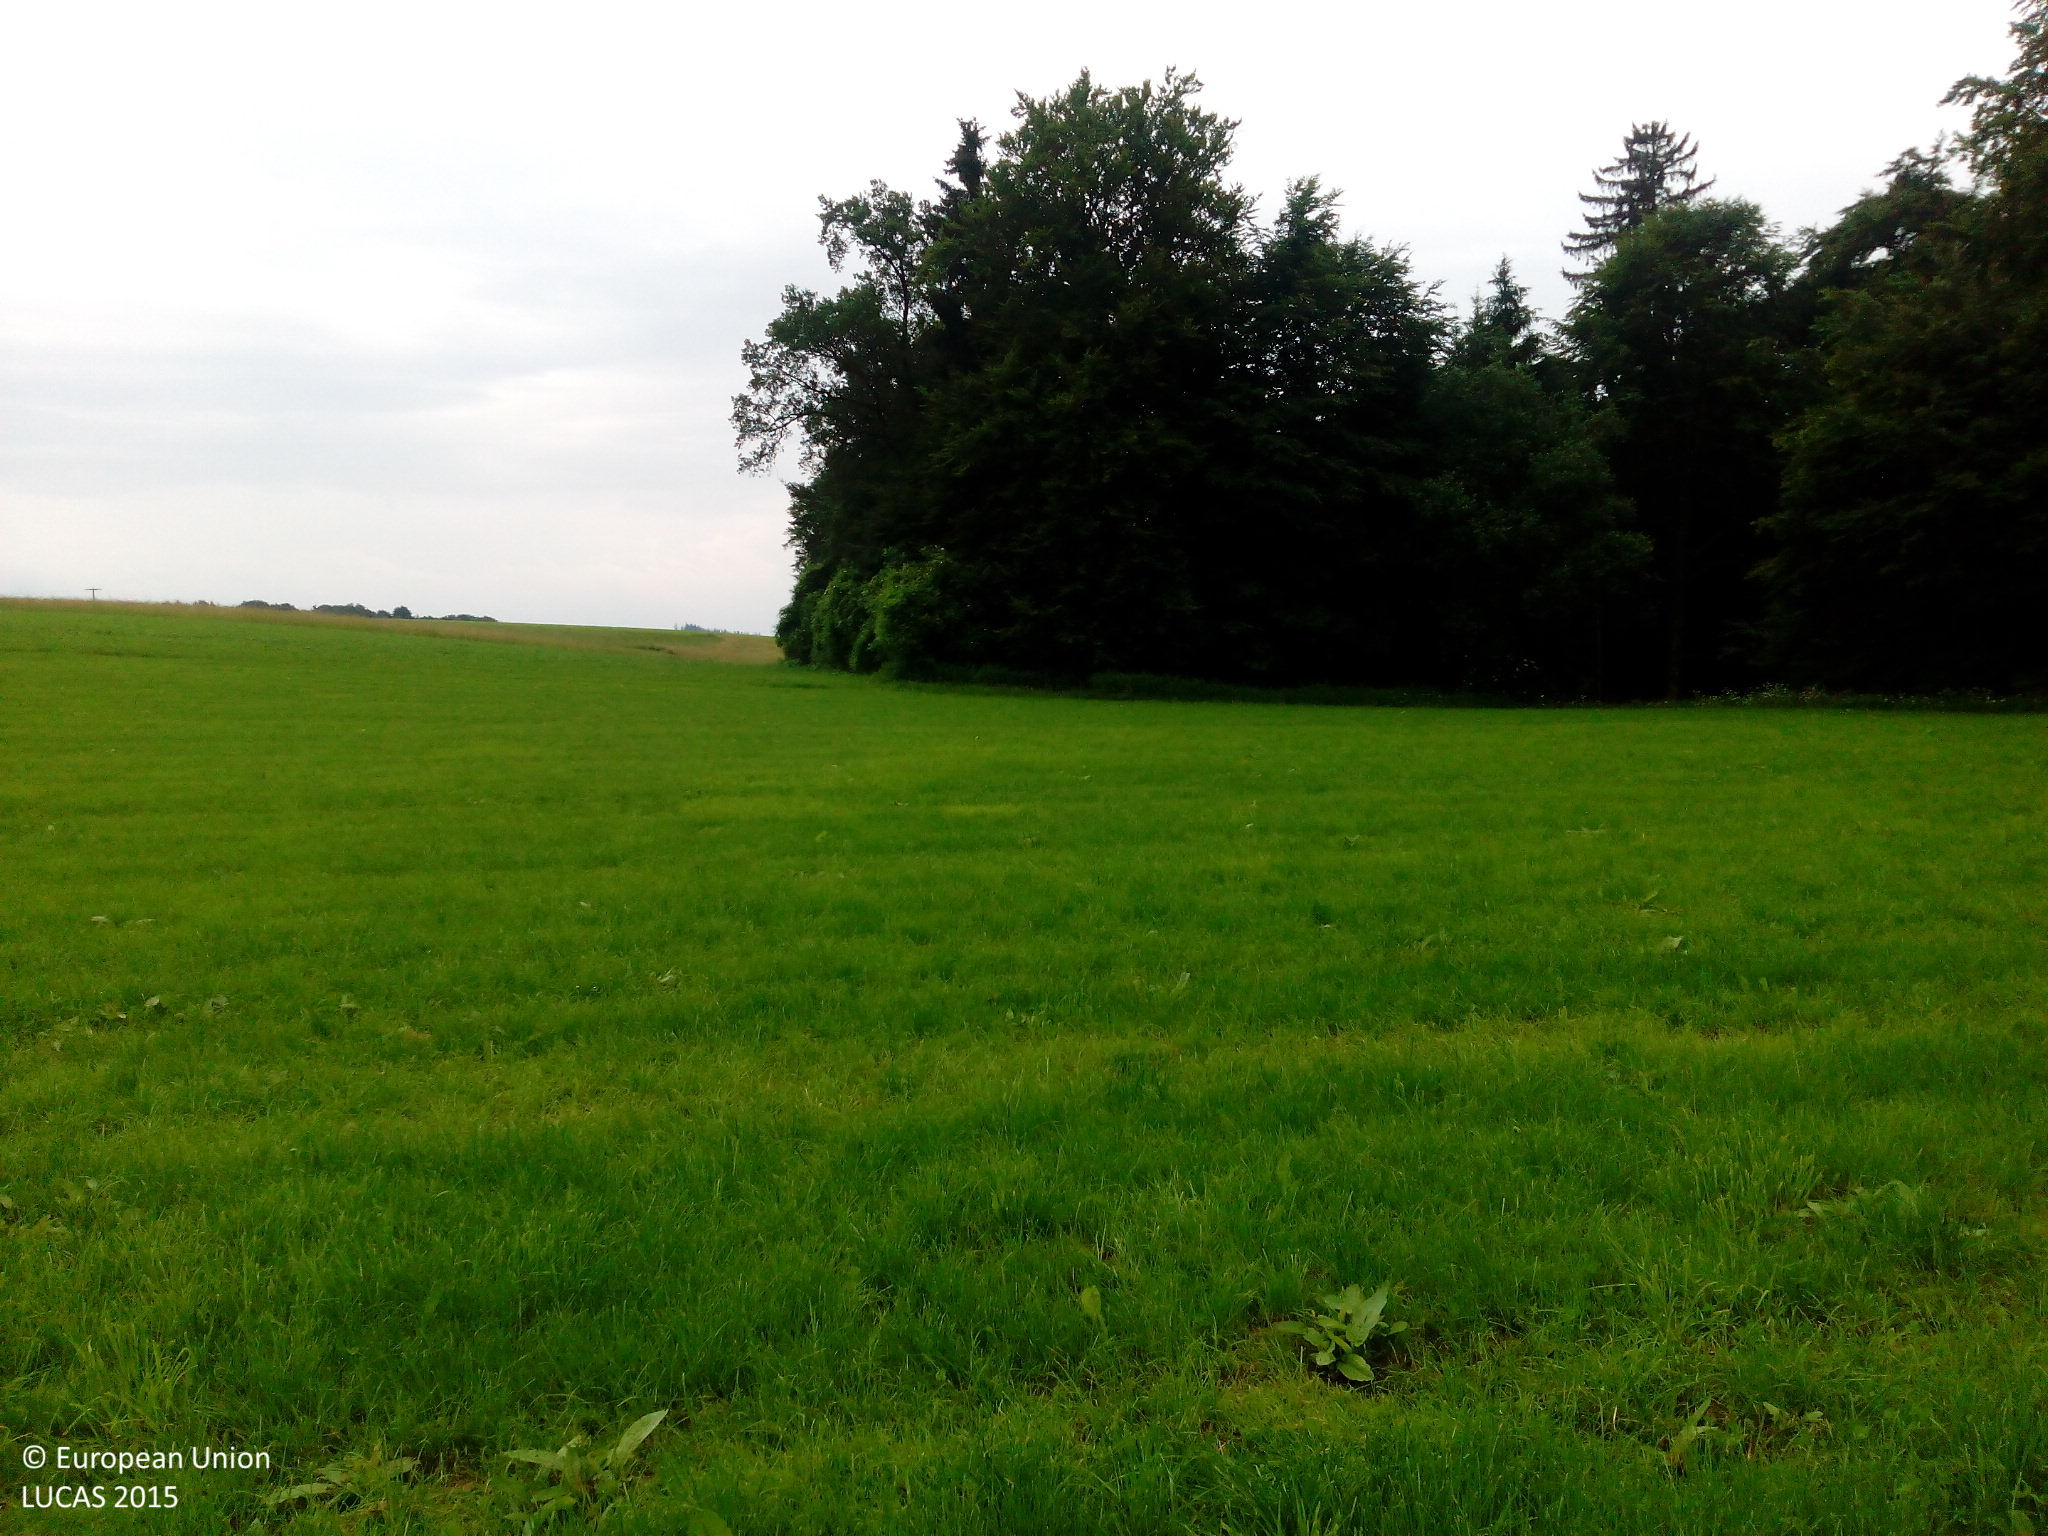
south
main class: Grassland
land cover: Grassland without tree/shrub cover
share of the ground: > 75 %
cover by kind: herbaceous plants 100 %
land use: Agriculture (excluding fallow land and kitchen gardens)
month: June
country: DE
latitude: 47.8913
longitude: 11.3499
